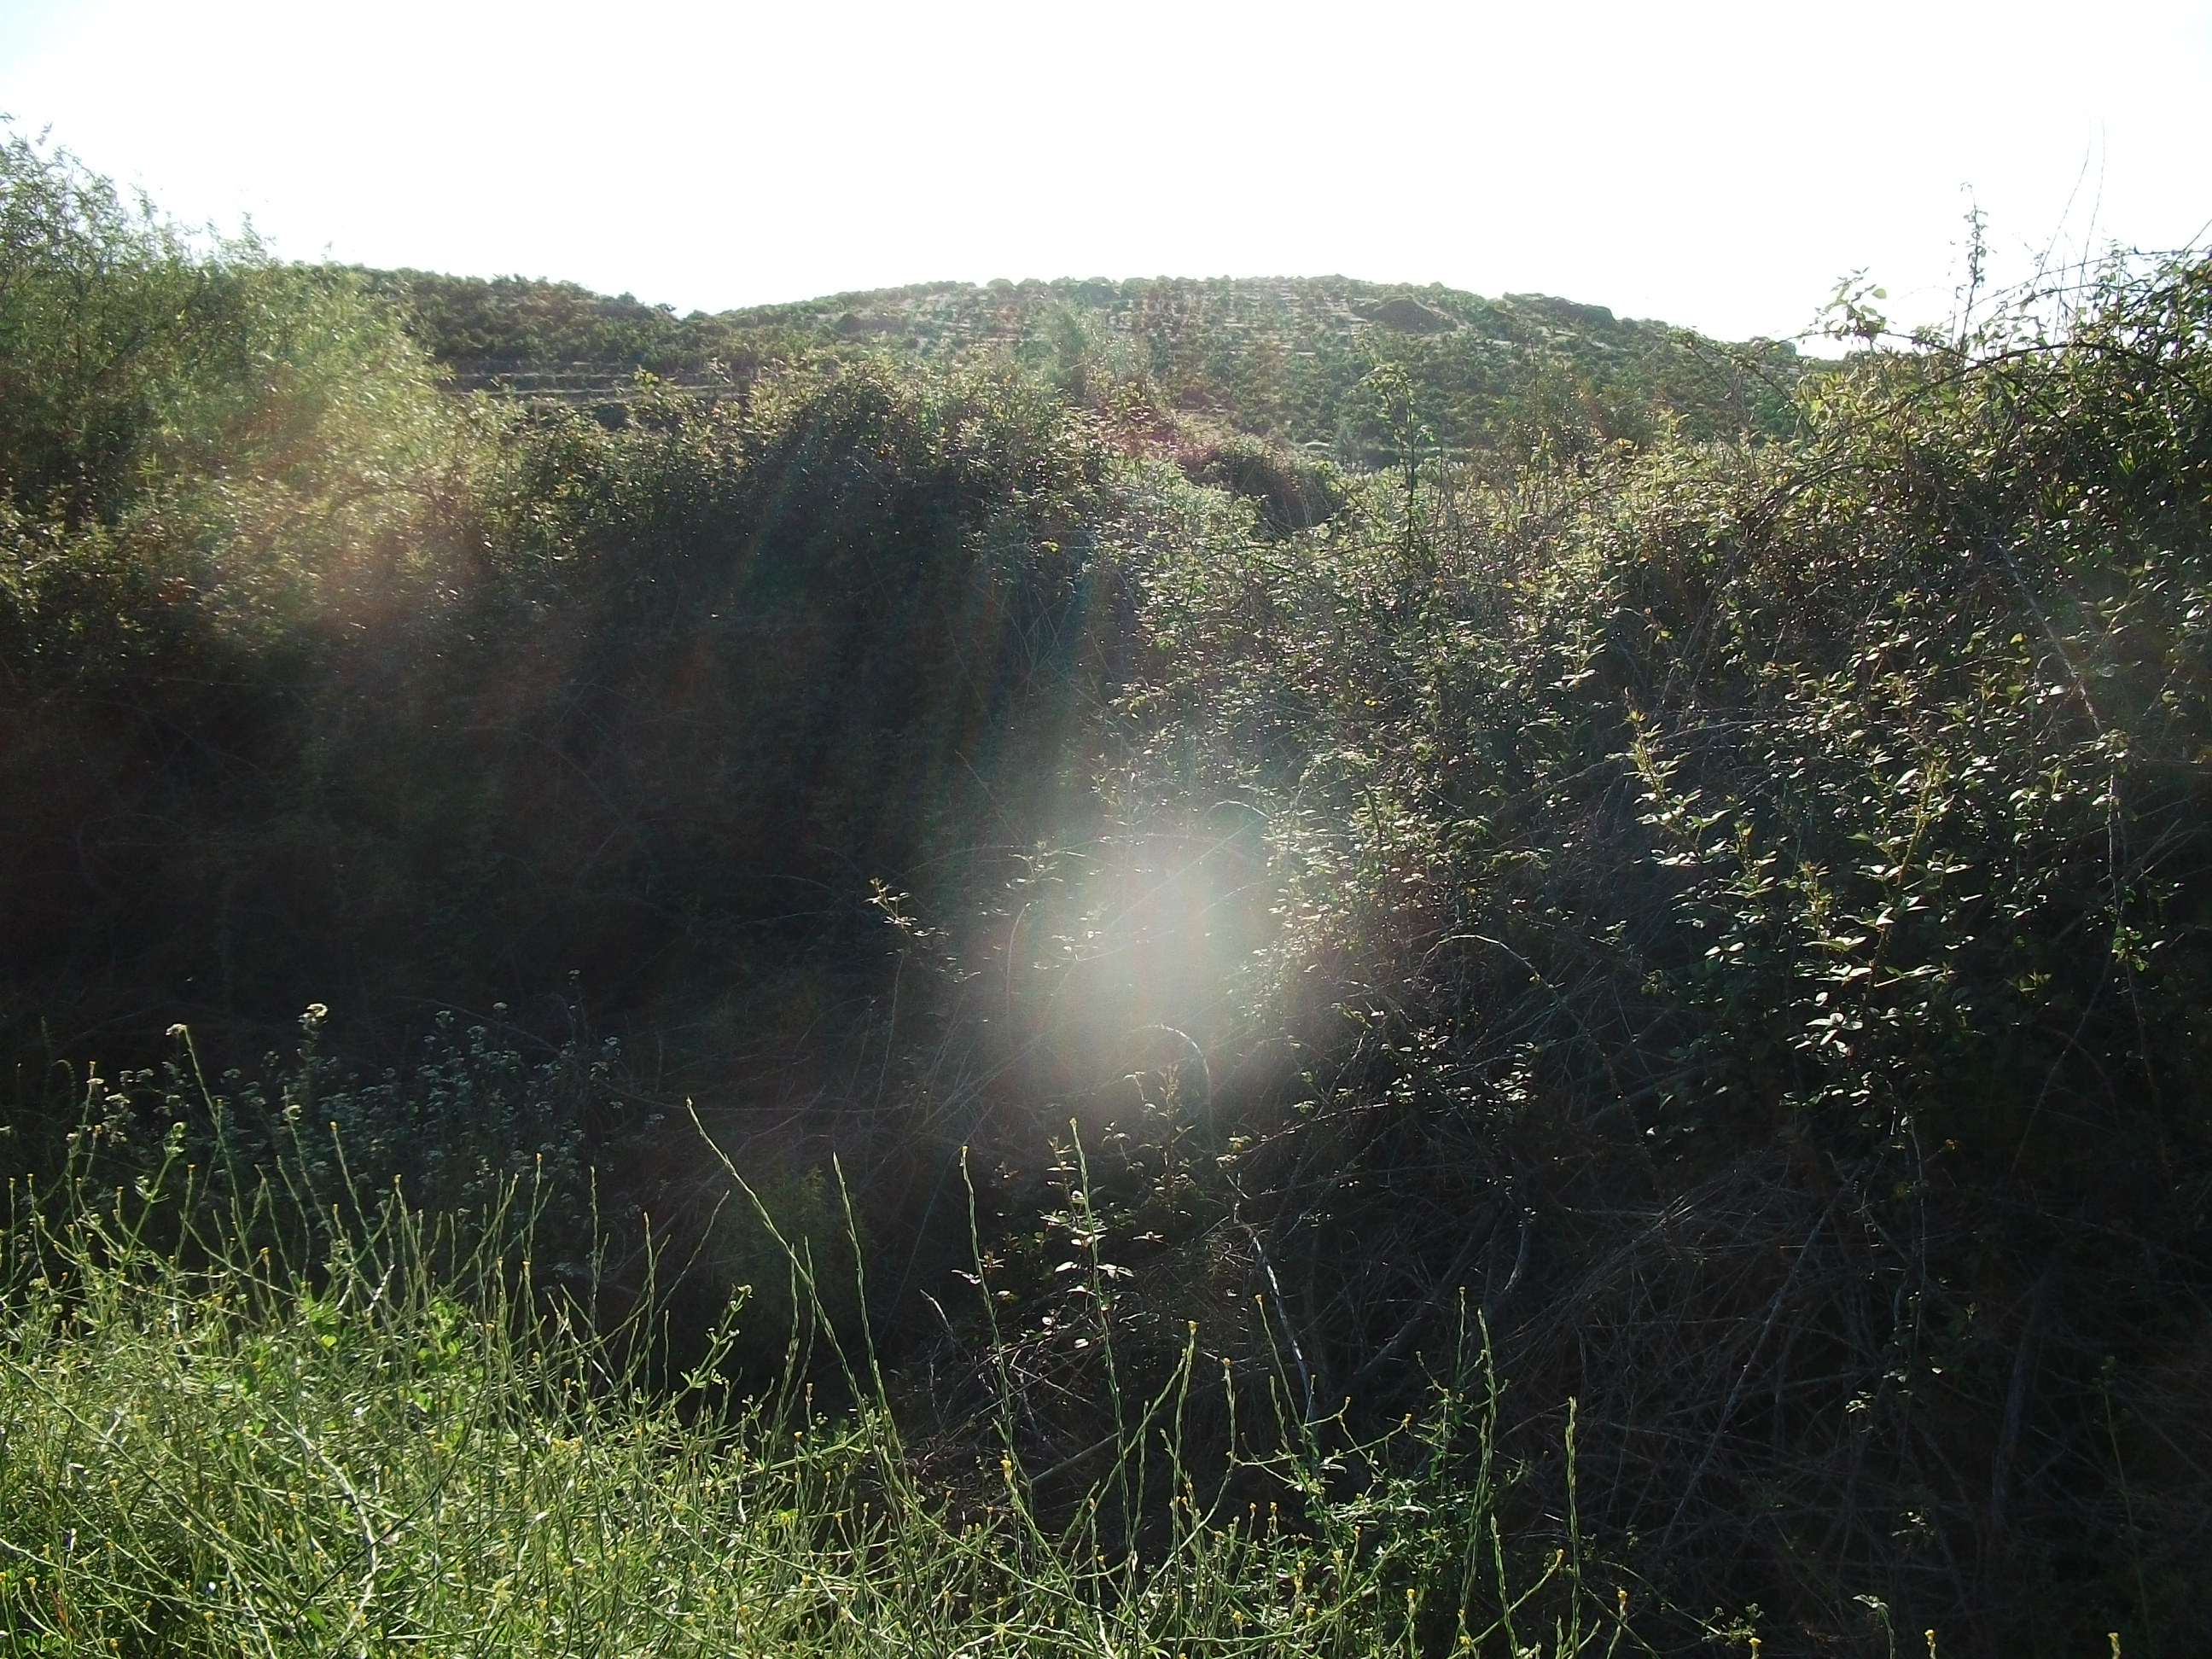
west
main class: Shrubland
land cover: Shrubland without tree cover
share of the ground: > 75 %
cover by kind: shrubs 100 %
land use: Semi-natural and natural areas not in use
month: April
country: ES
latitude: 37.6616
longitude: -6.6016
